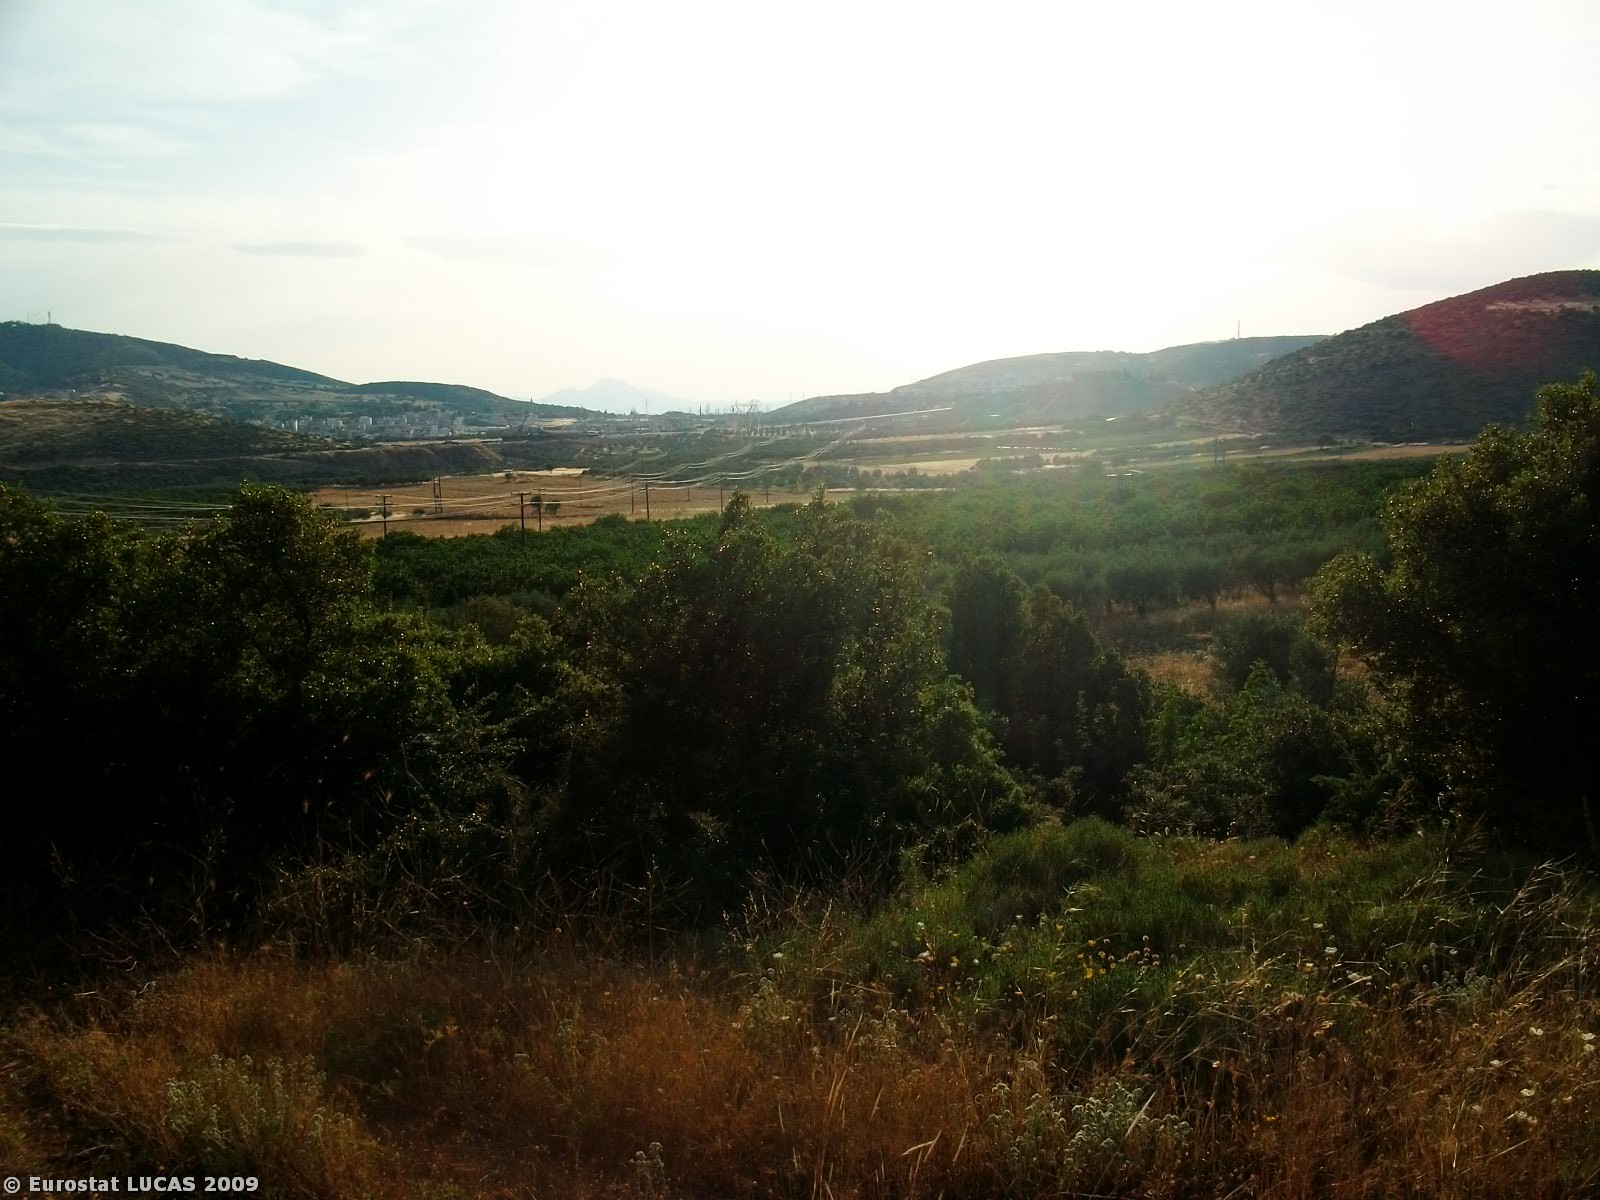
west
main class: Shrubland
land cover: Shrubland with sparse tree cover
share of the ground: 25 - 50 %
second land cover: Olive groves
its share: 25 - 50 %
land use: Unused
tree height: < 5 m
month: June
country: GR
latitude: 38.9223
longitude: 22.4495
